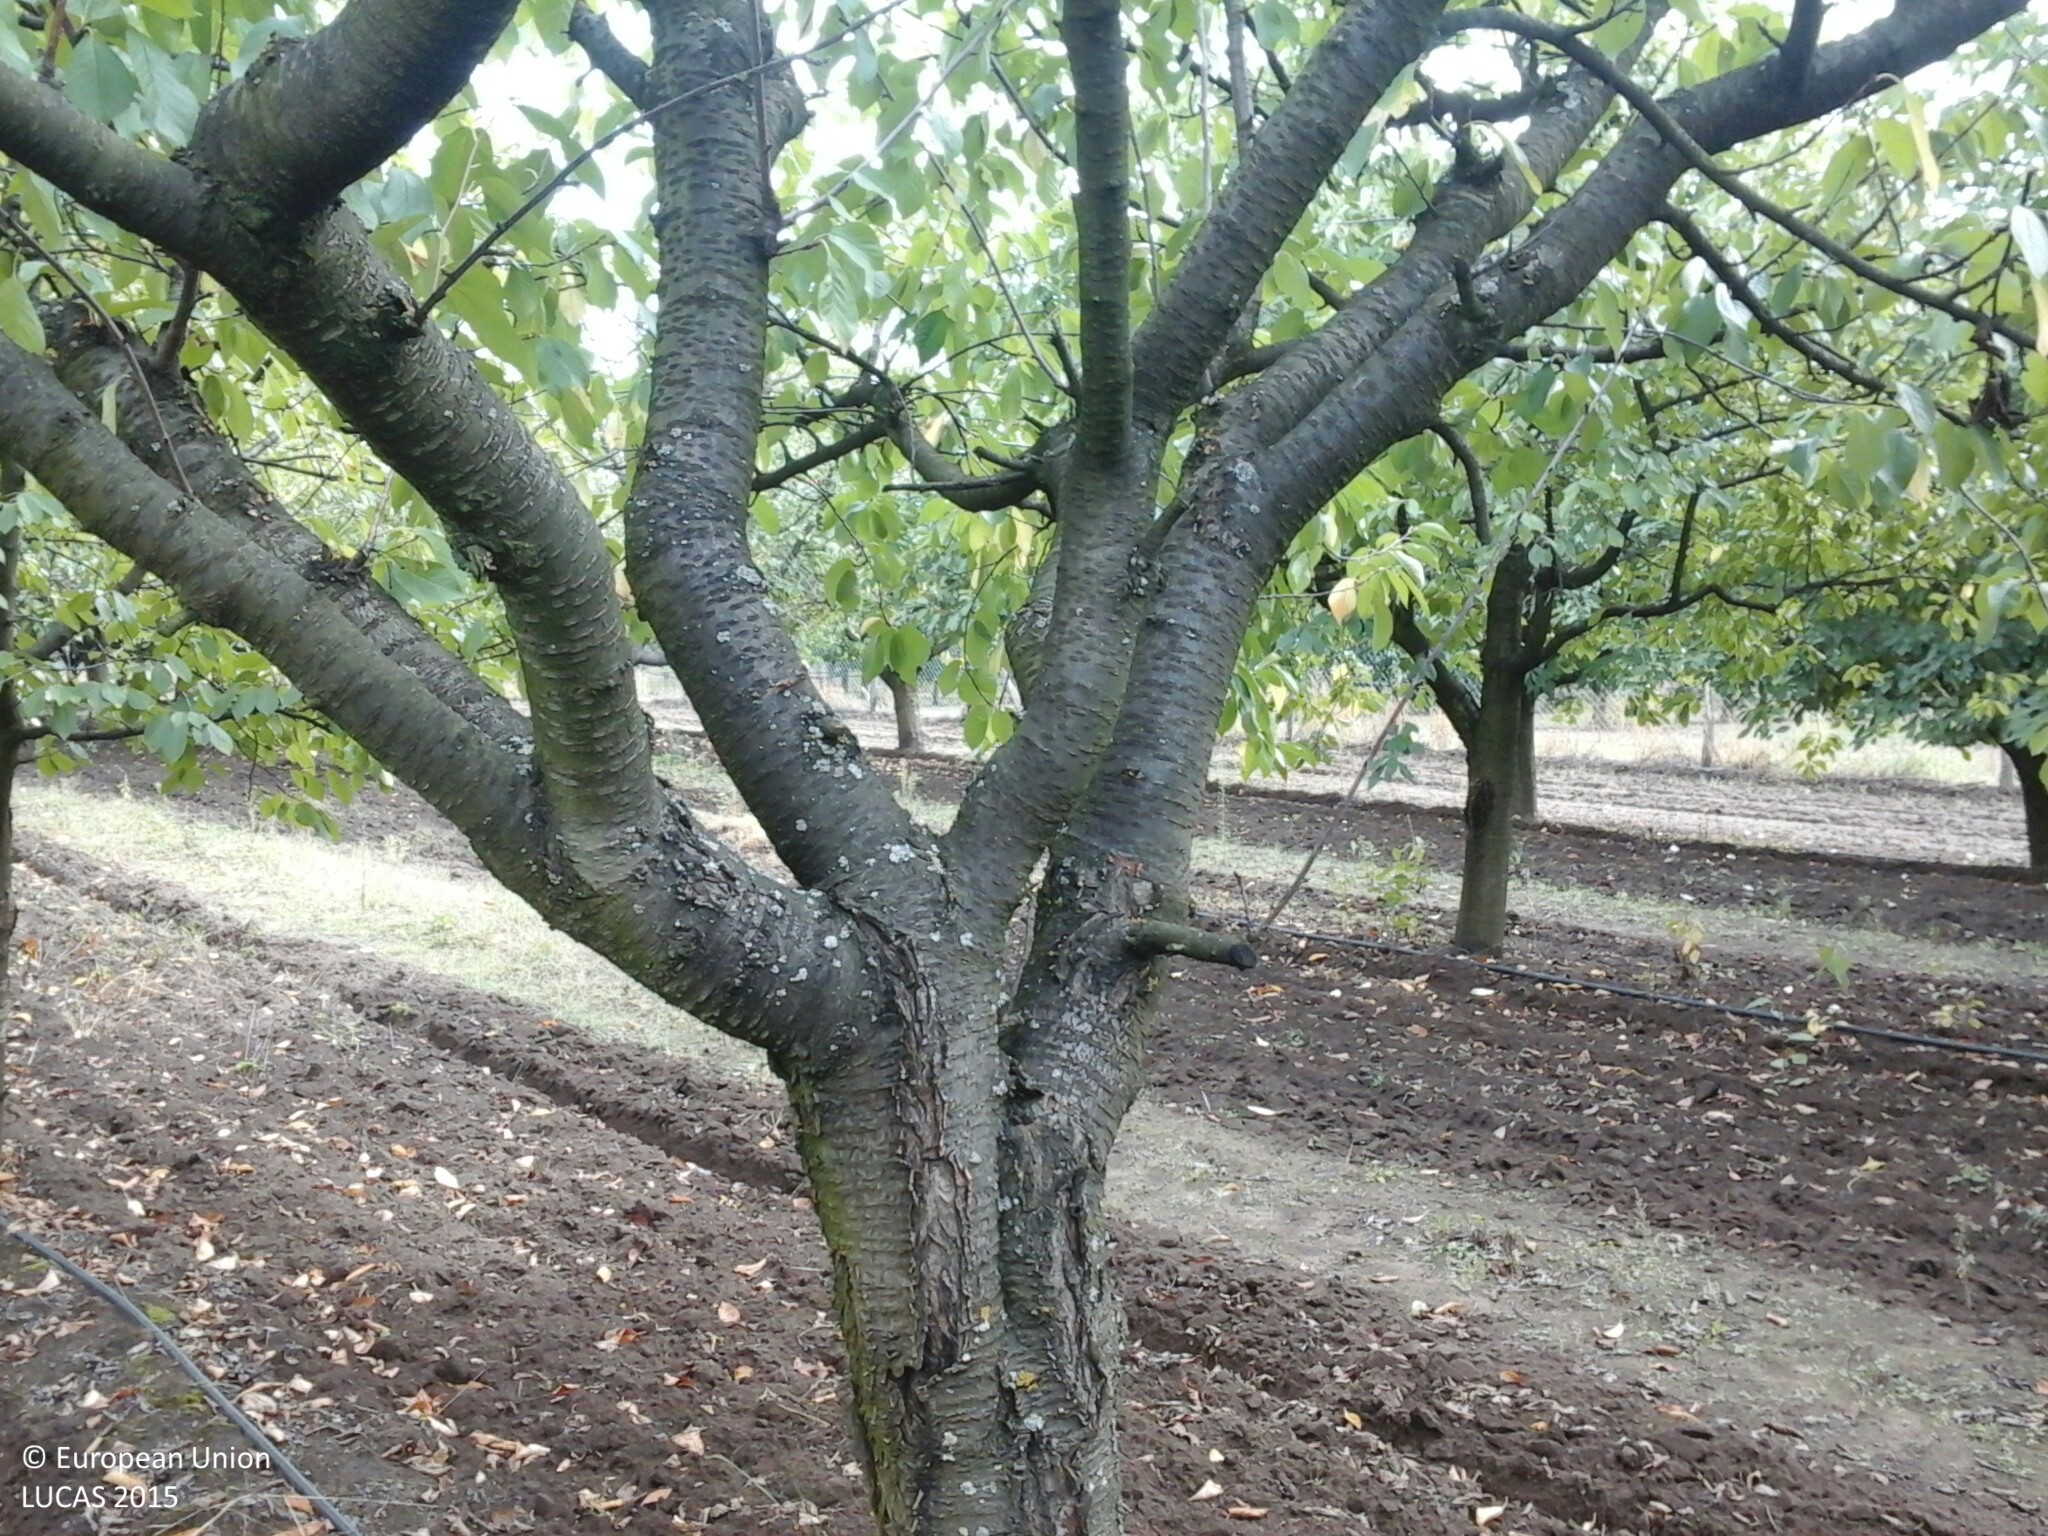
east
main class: Cropland
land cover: Cherry fruit
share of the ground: 50 - 75 %
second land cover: Other bare soil
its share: > 75 %
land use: Agriculture (excluding fallow land and kitchen gardens)
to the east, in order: Cherry fruit; Other bare soil; Fences; Grassland without tree/shrub cover; Cherry fruit; Grass margins; Fences; Grass margins; Tracks; Grass margins; Sunflower
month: September
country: HU
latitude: 47.6650
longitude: 20.3238
